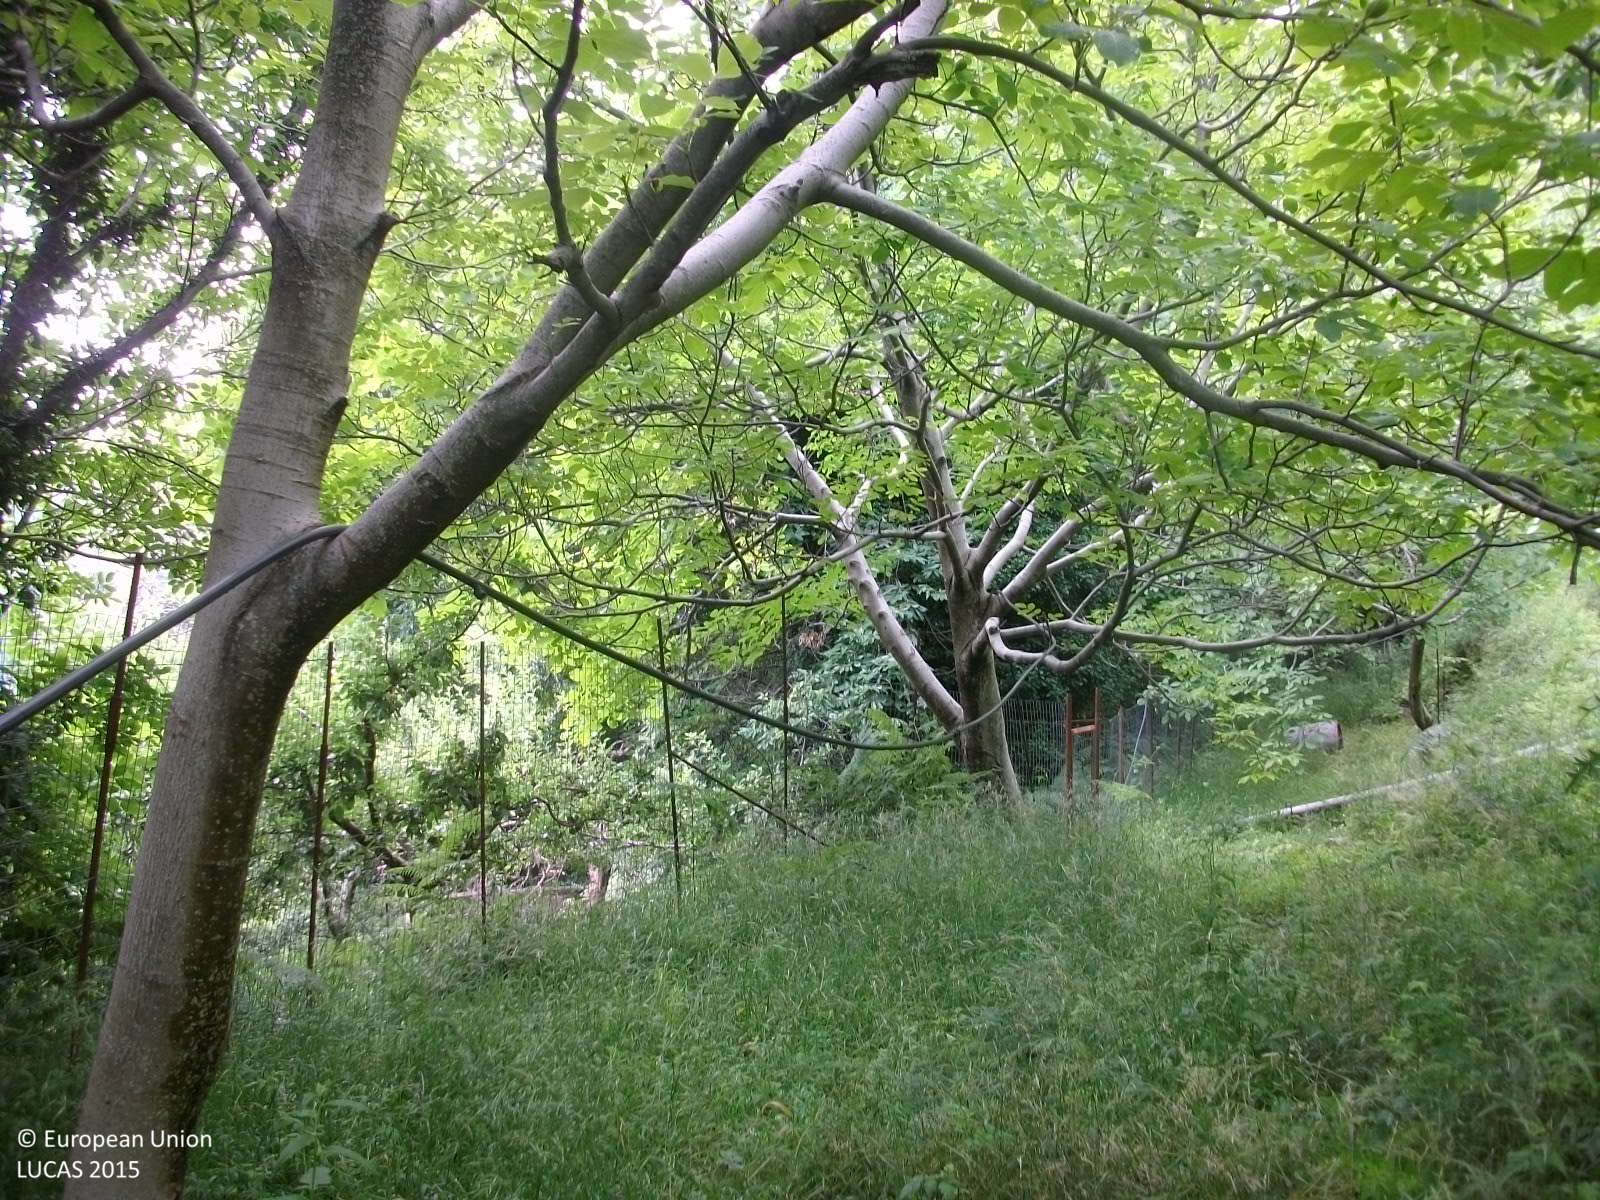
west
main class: Woodland
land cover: Broadleaved woodland
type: thermophilous deciduous forest
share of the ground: > 75 %
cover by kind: broadleaved forest trees 100 %
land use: Semi-natural and natural areas not in use
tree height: > 5 m
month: June
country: GR
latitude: 39.3428
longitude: 23.1393
